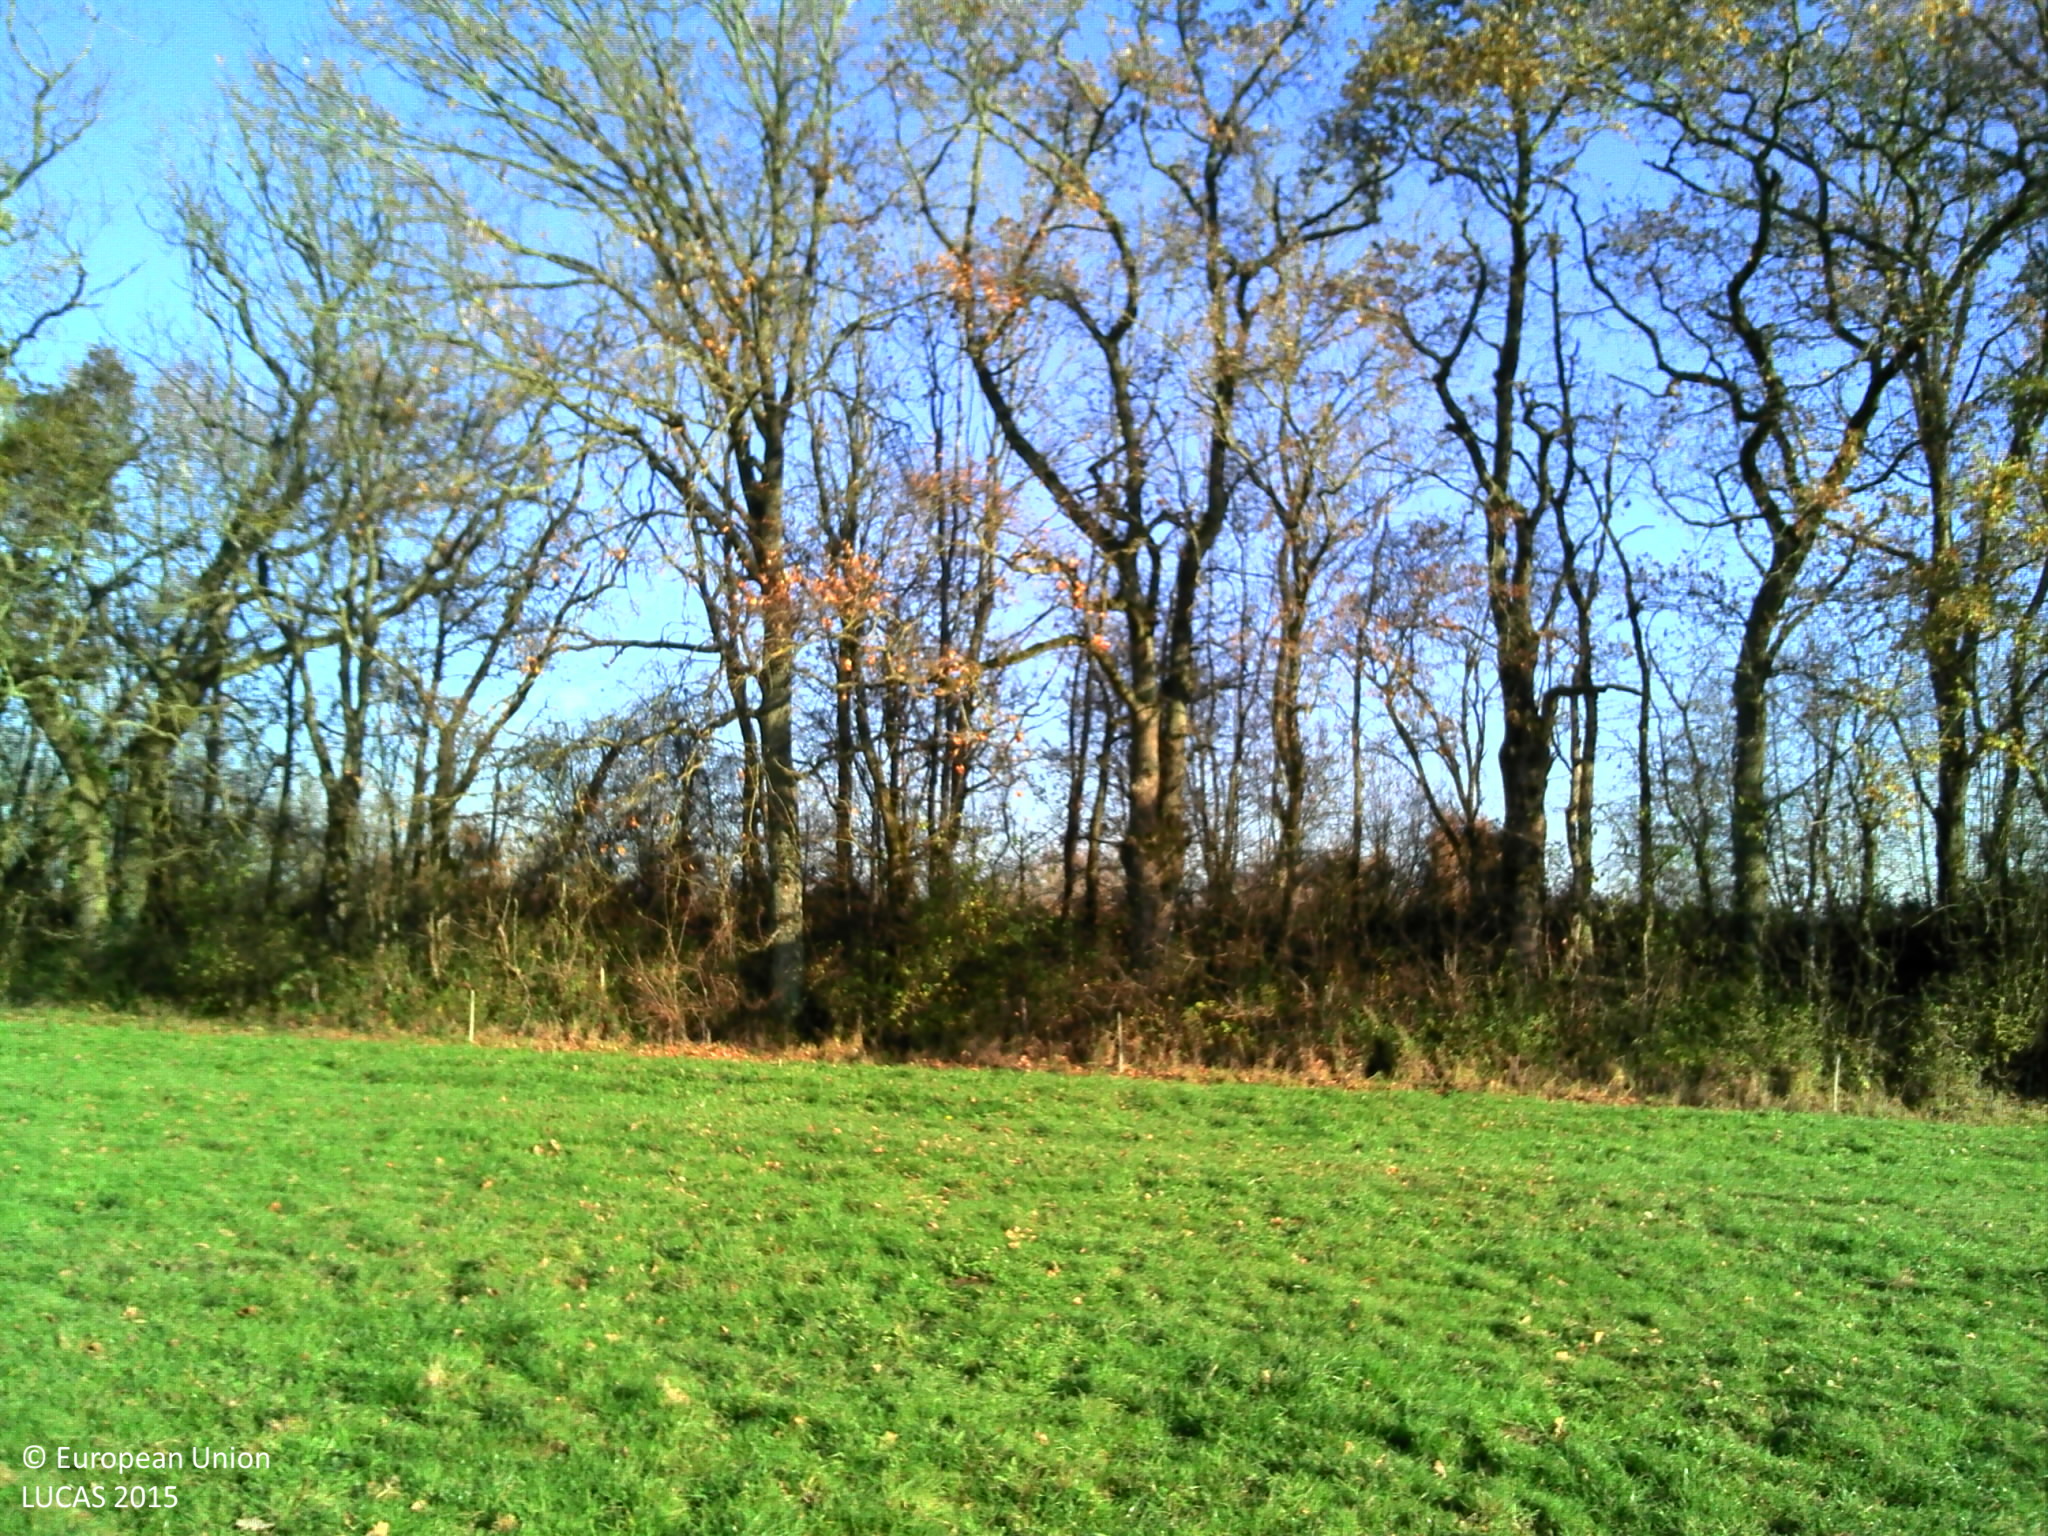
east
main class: Grassland
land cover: Grassland without tree/shrub cover
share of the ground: > 75 %
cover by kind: herbaceous plants 100 %
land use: Agriculture (excluding fallow land and kitchen gardens)
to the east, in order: Grassland without tree/shrub cover; Fences; Broadleaved woodland; Tracks; Broadleaved woodland; Inland fresh water bodies; Broadleaved woodland; Spontaneously vegetated surfaces; Grass margins; Maize
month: December
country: FR
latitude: 46.0323
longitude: 4.9255
